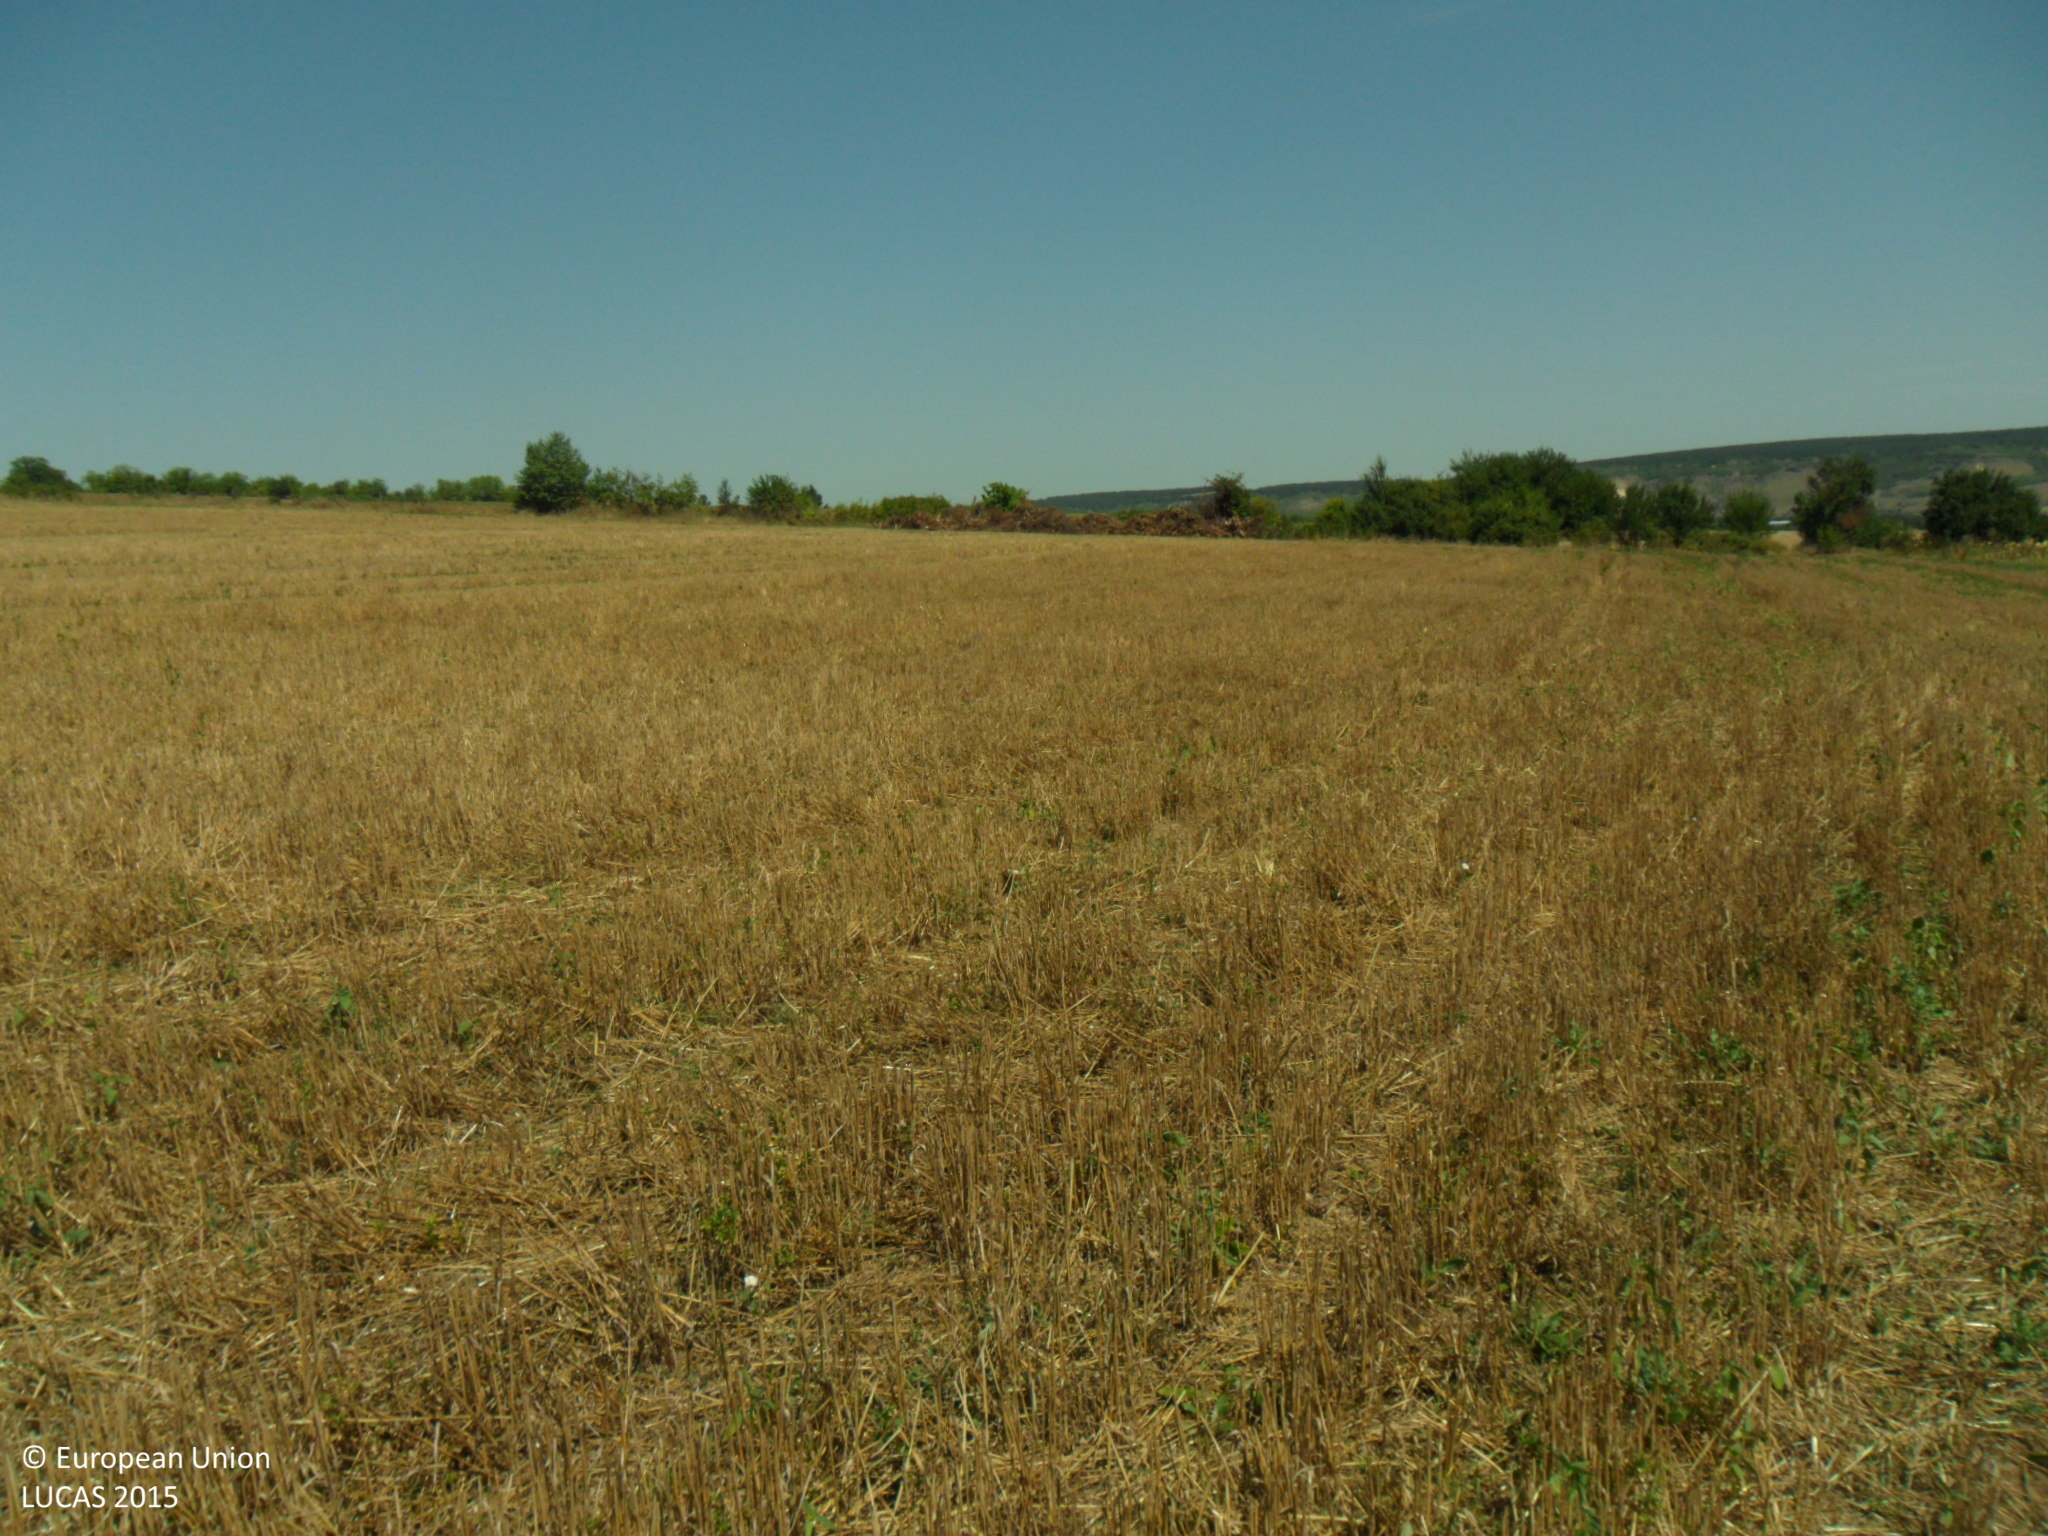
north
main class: Cropland
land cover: Common wheat
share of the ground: 25 - 50 %
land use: Agriculture (excluding fallow land and kitchen gardens)
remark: Harvested field
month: August
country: BG
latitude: 43.5489
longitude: 26.4040
